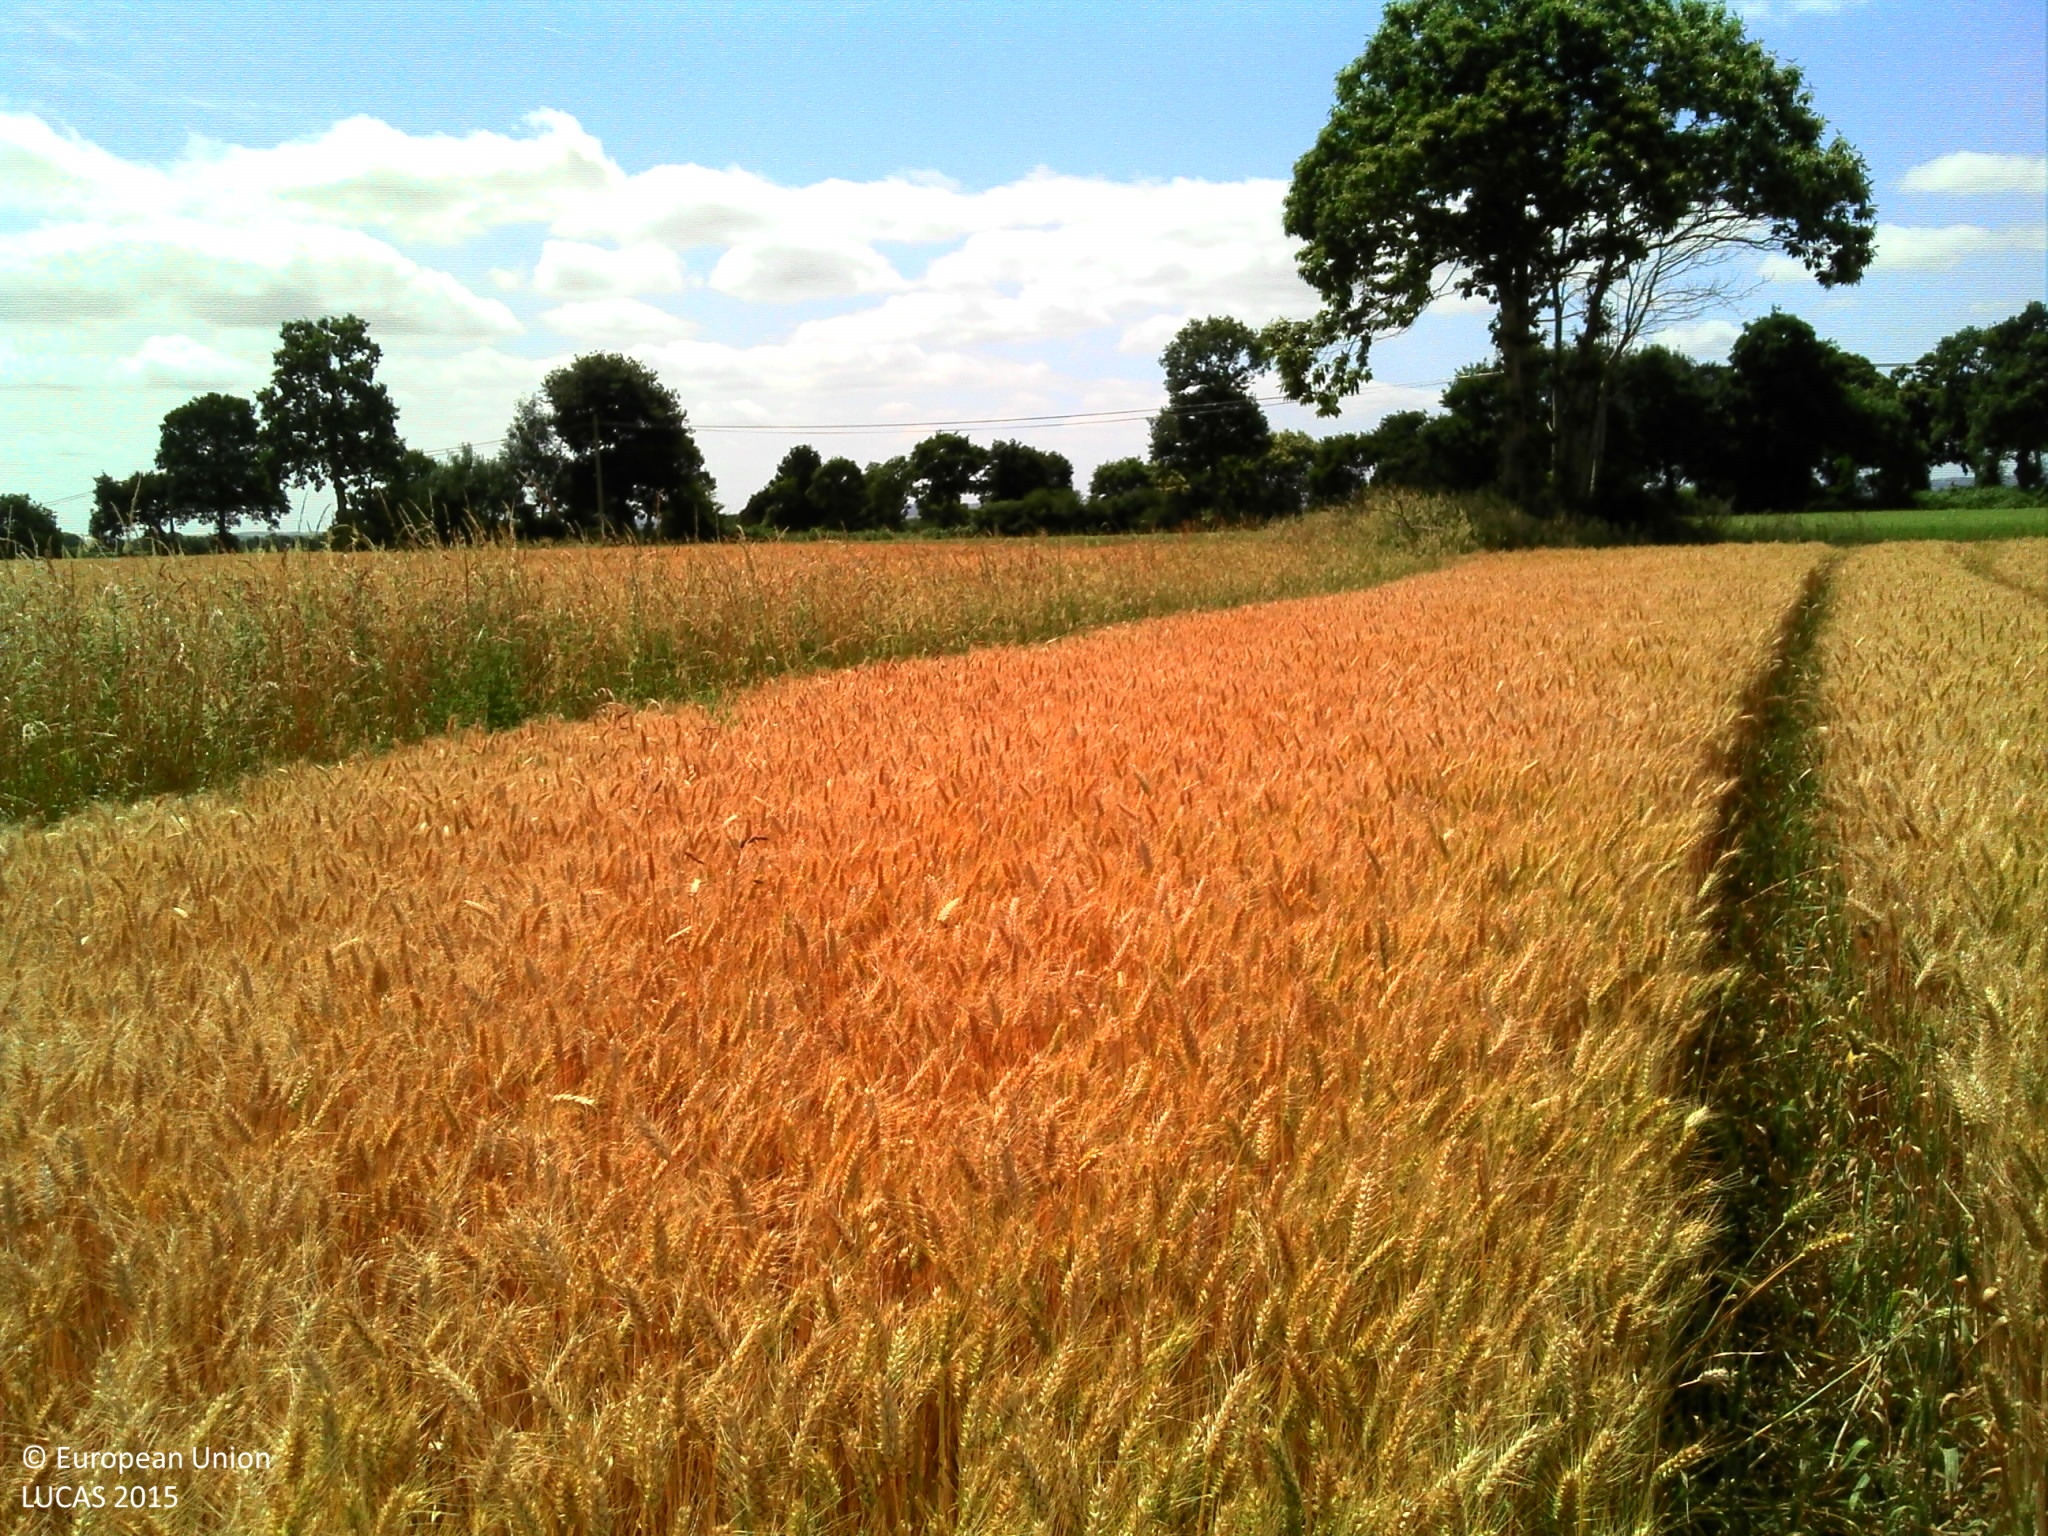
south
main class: Cropland
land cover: Durum wheat
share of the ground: > 75 %
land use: Agriculture (excluding fallow land and kitchen gardens)
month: July
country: FR
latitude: 48.4218
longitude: -1.9855
